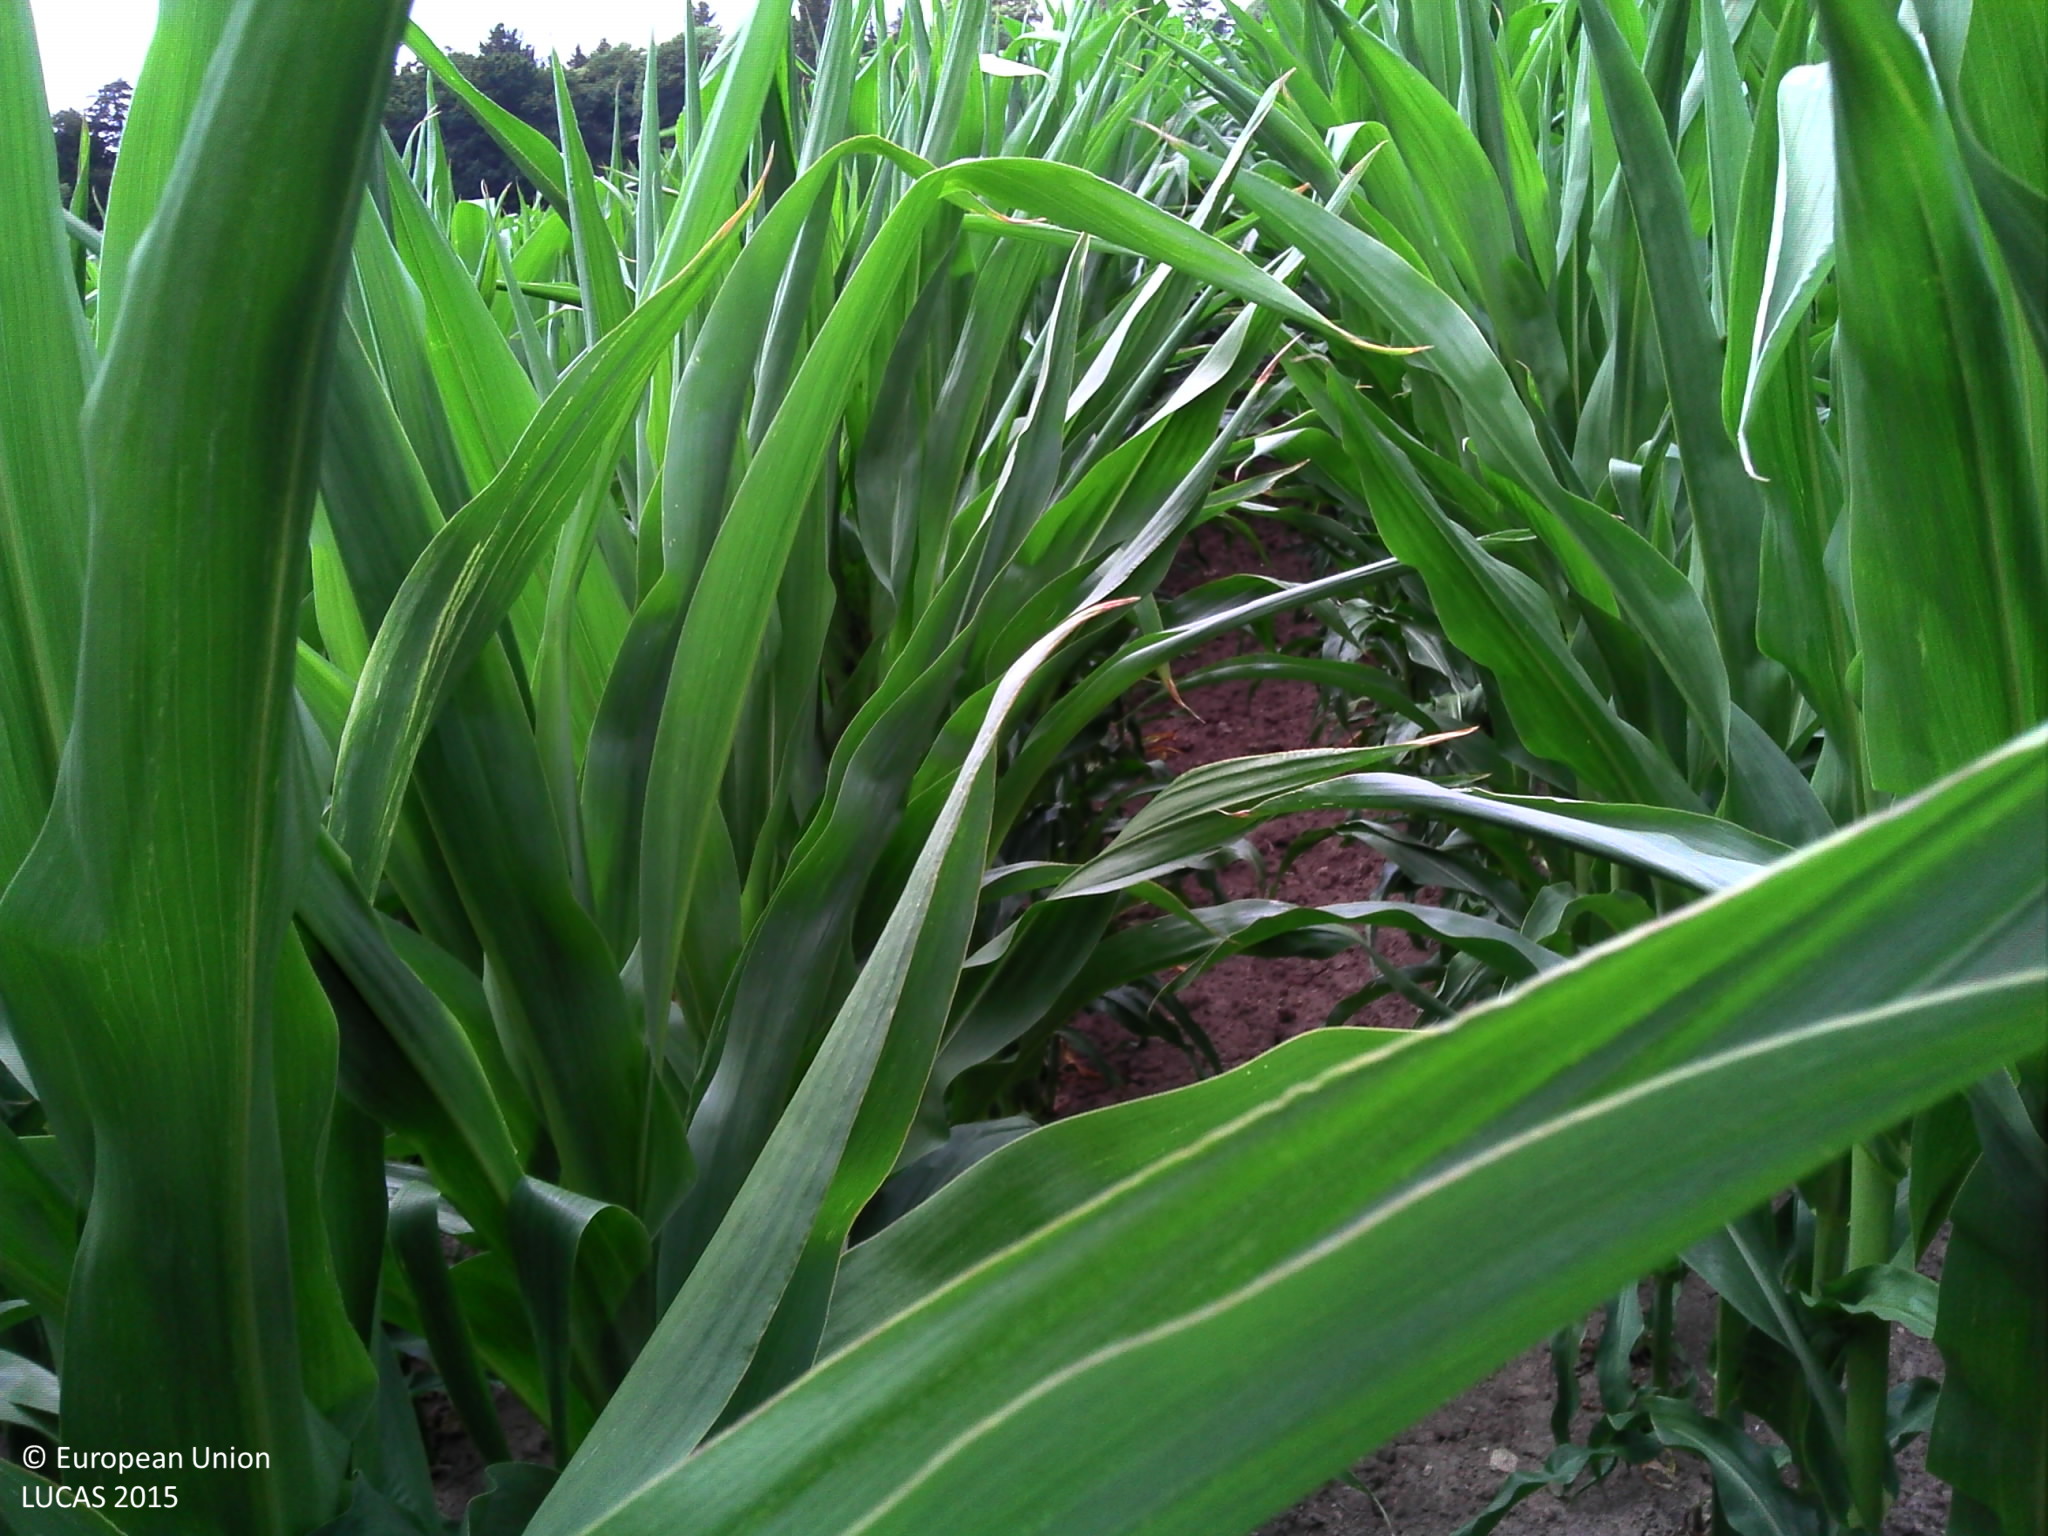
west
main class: Cropland
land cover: Maize
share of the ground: > 75 %
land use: Agriculture (excluding fallow land and kitchen gardens)
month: July
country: FR
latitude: 47.8377
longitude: -3.2586
